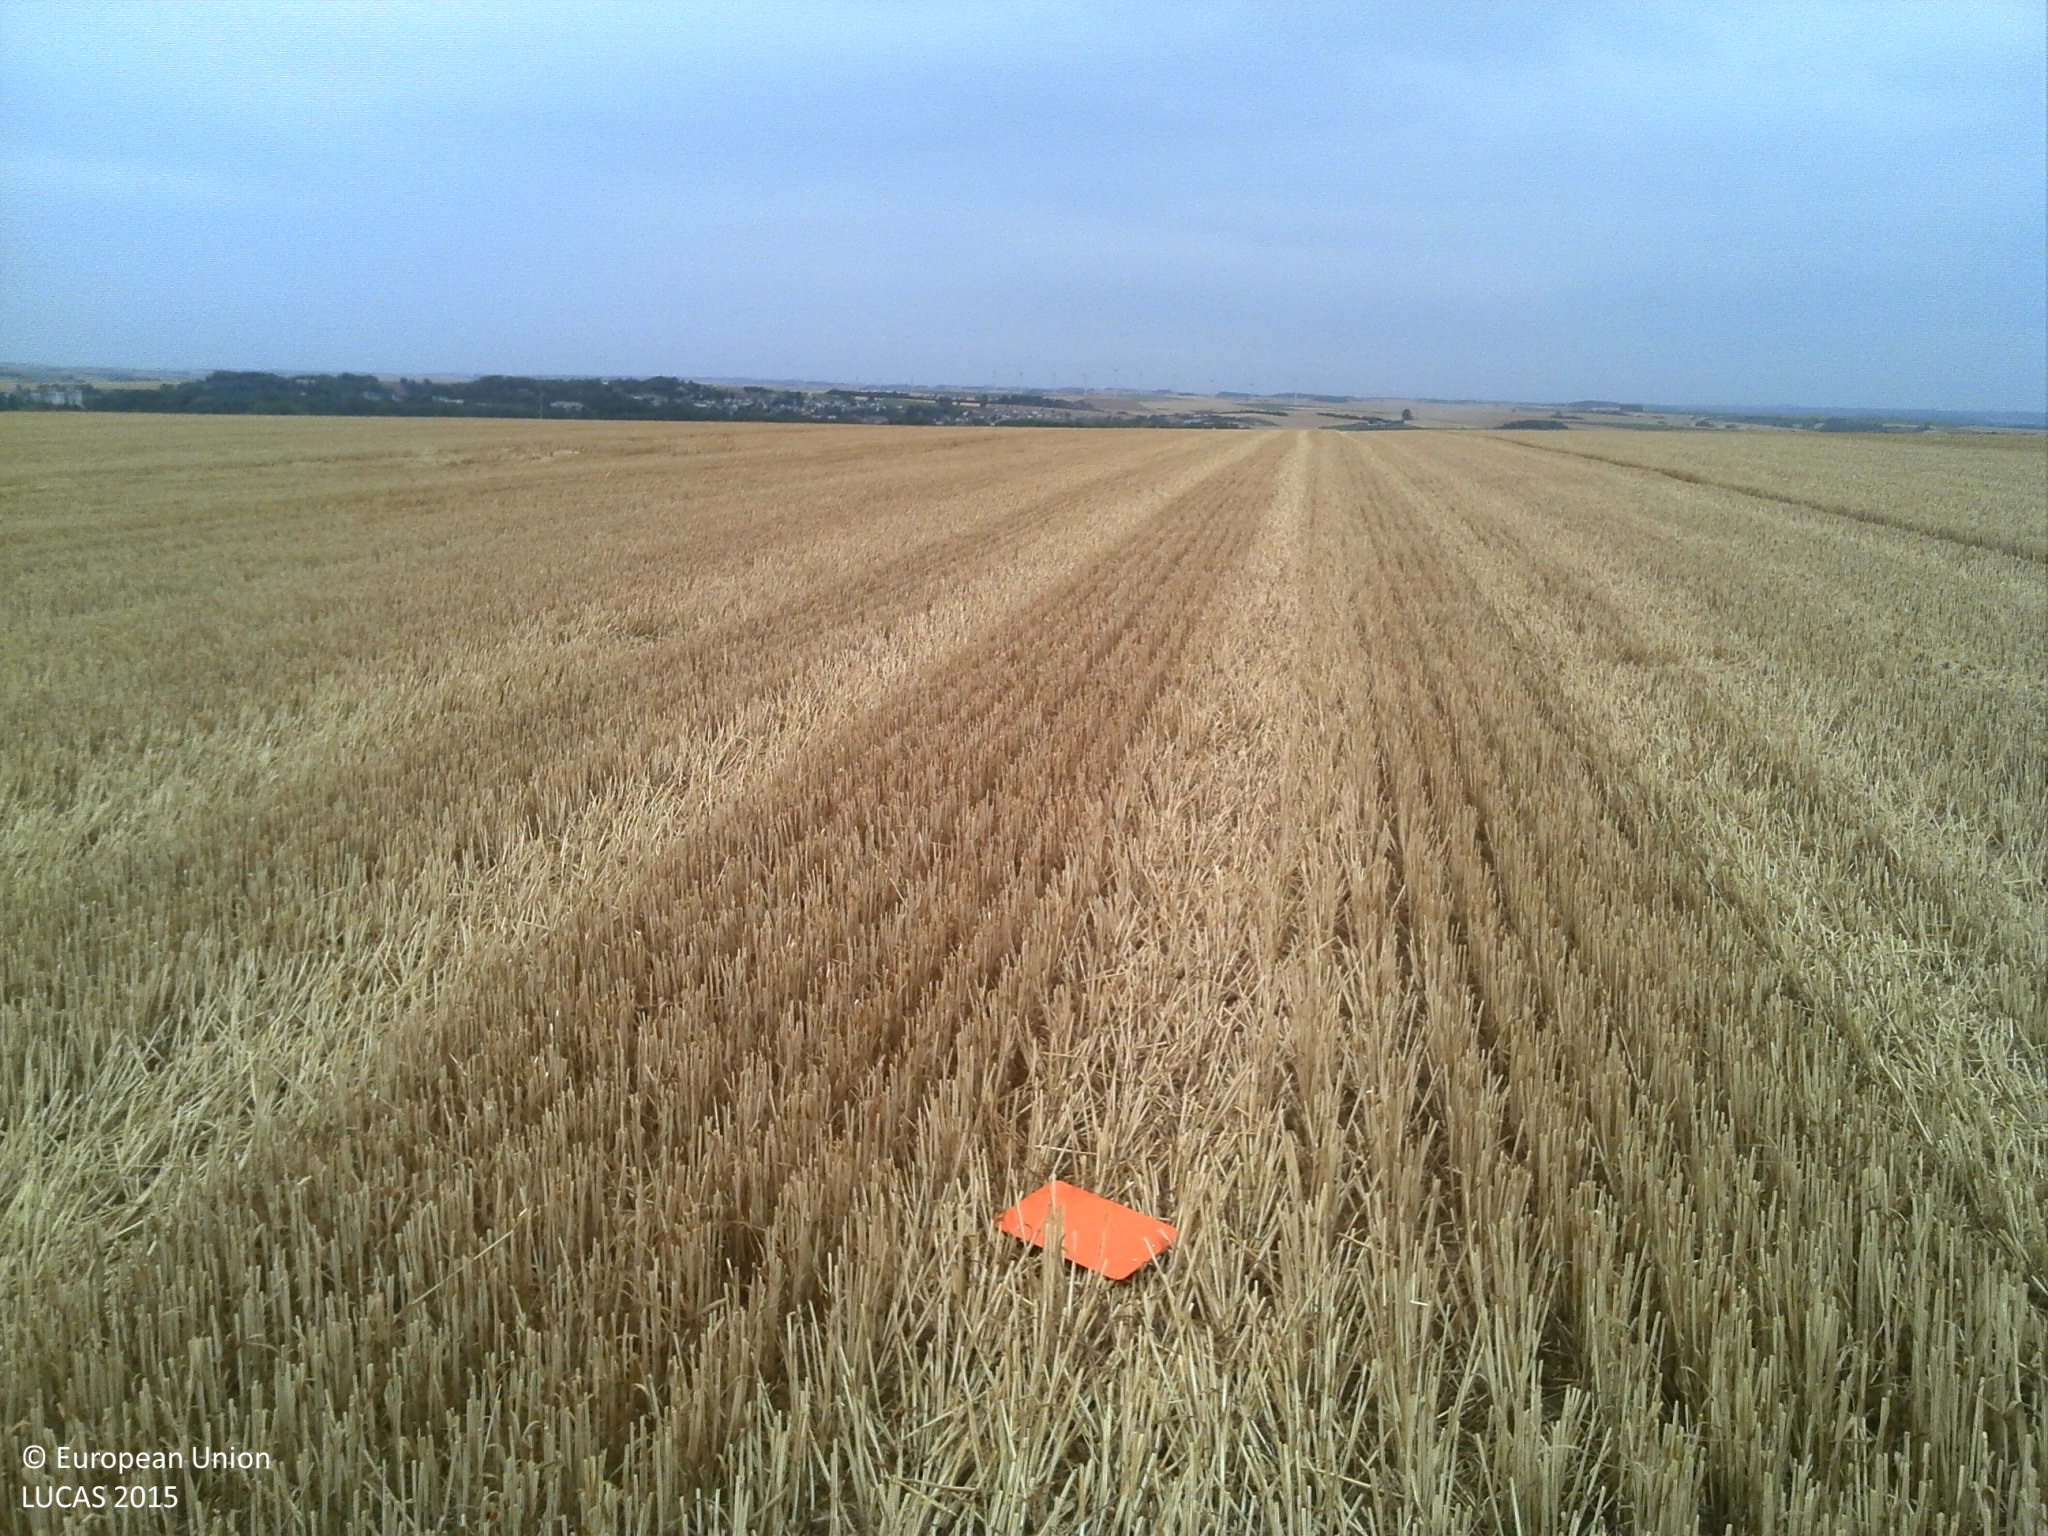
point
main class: Cropland
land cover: Common wheat
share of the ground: > 75 %
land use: Agriculture (excluding fallow land and kitchen gardens)
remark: Harvested field
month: July
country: FR
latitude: 49.4991
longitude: 4.2654
